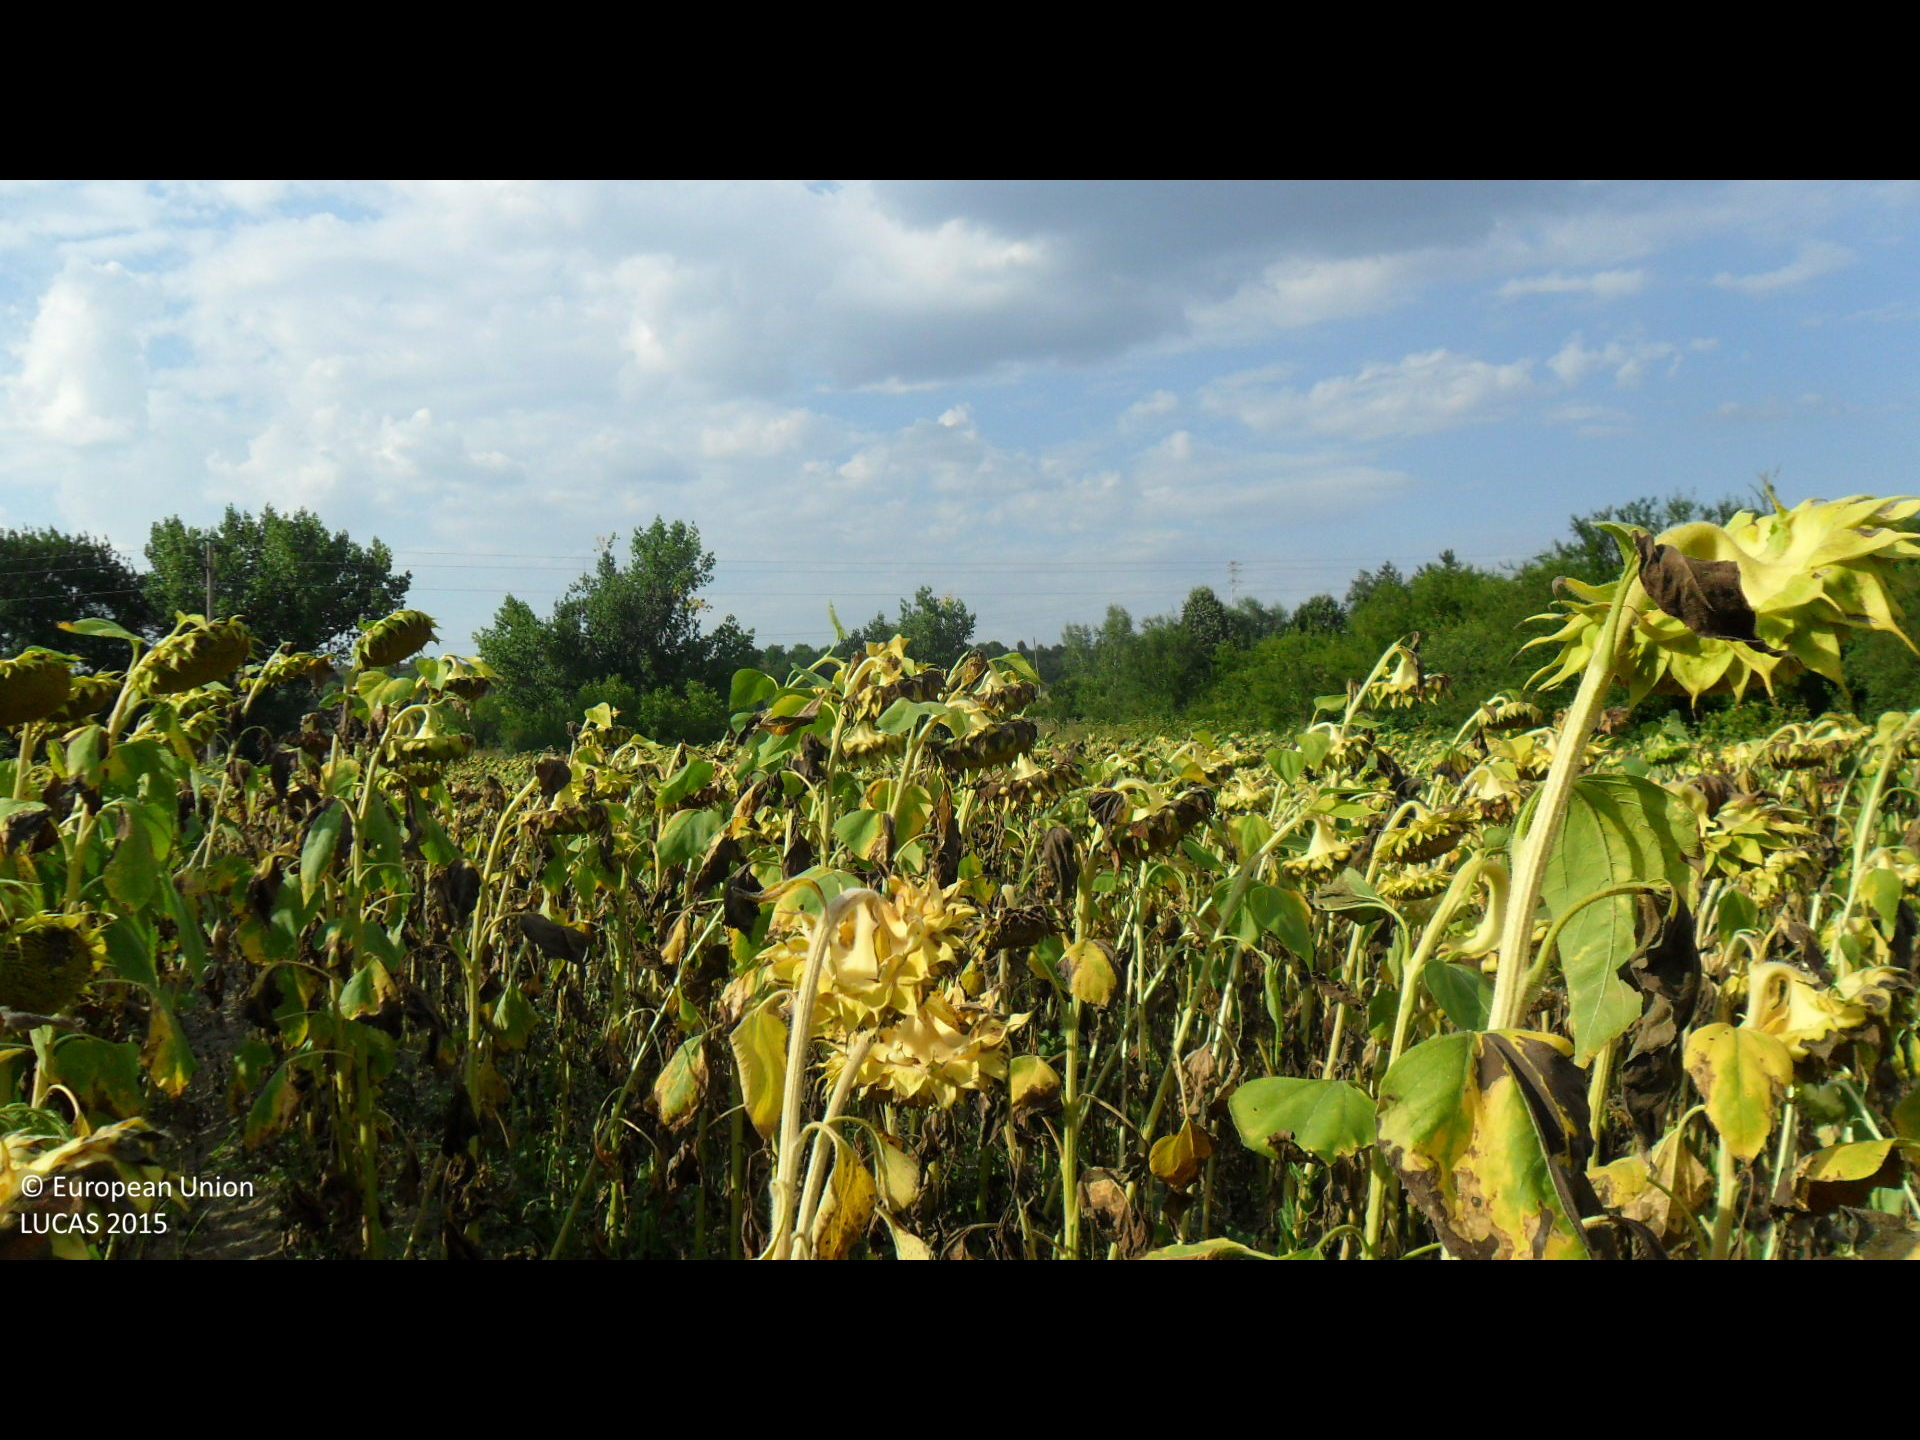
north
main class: Cropland
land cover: Sunflower
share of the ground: > 75 %
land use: Agriculture (excluding fallow land and kitchen gardens)
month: August
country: BG
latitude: 43.3555
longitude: 26.1210
